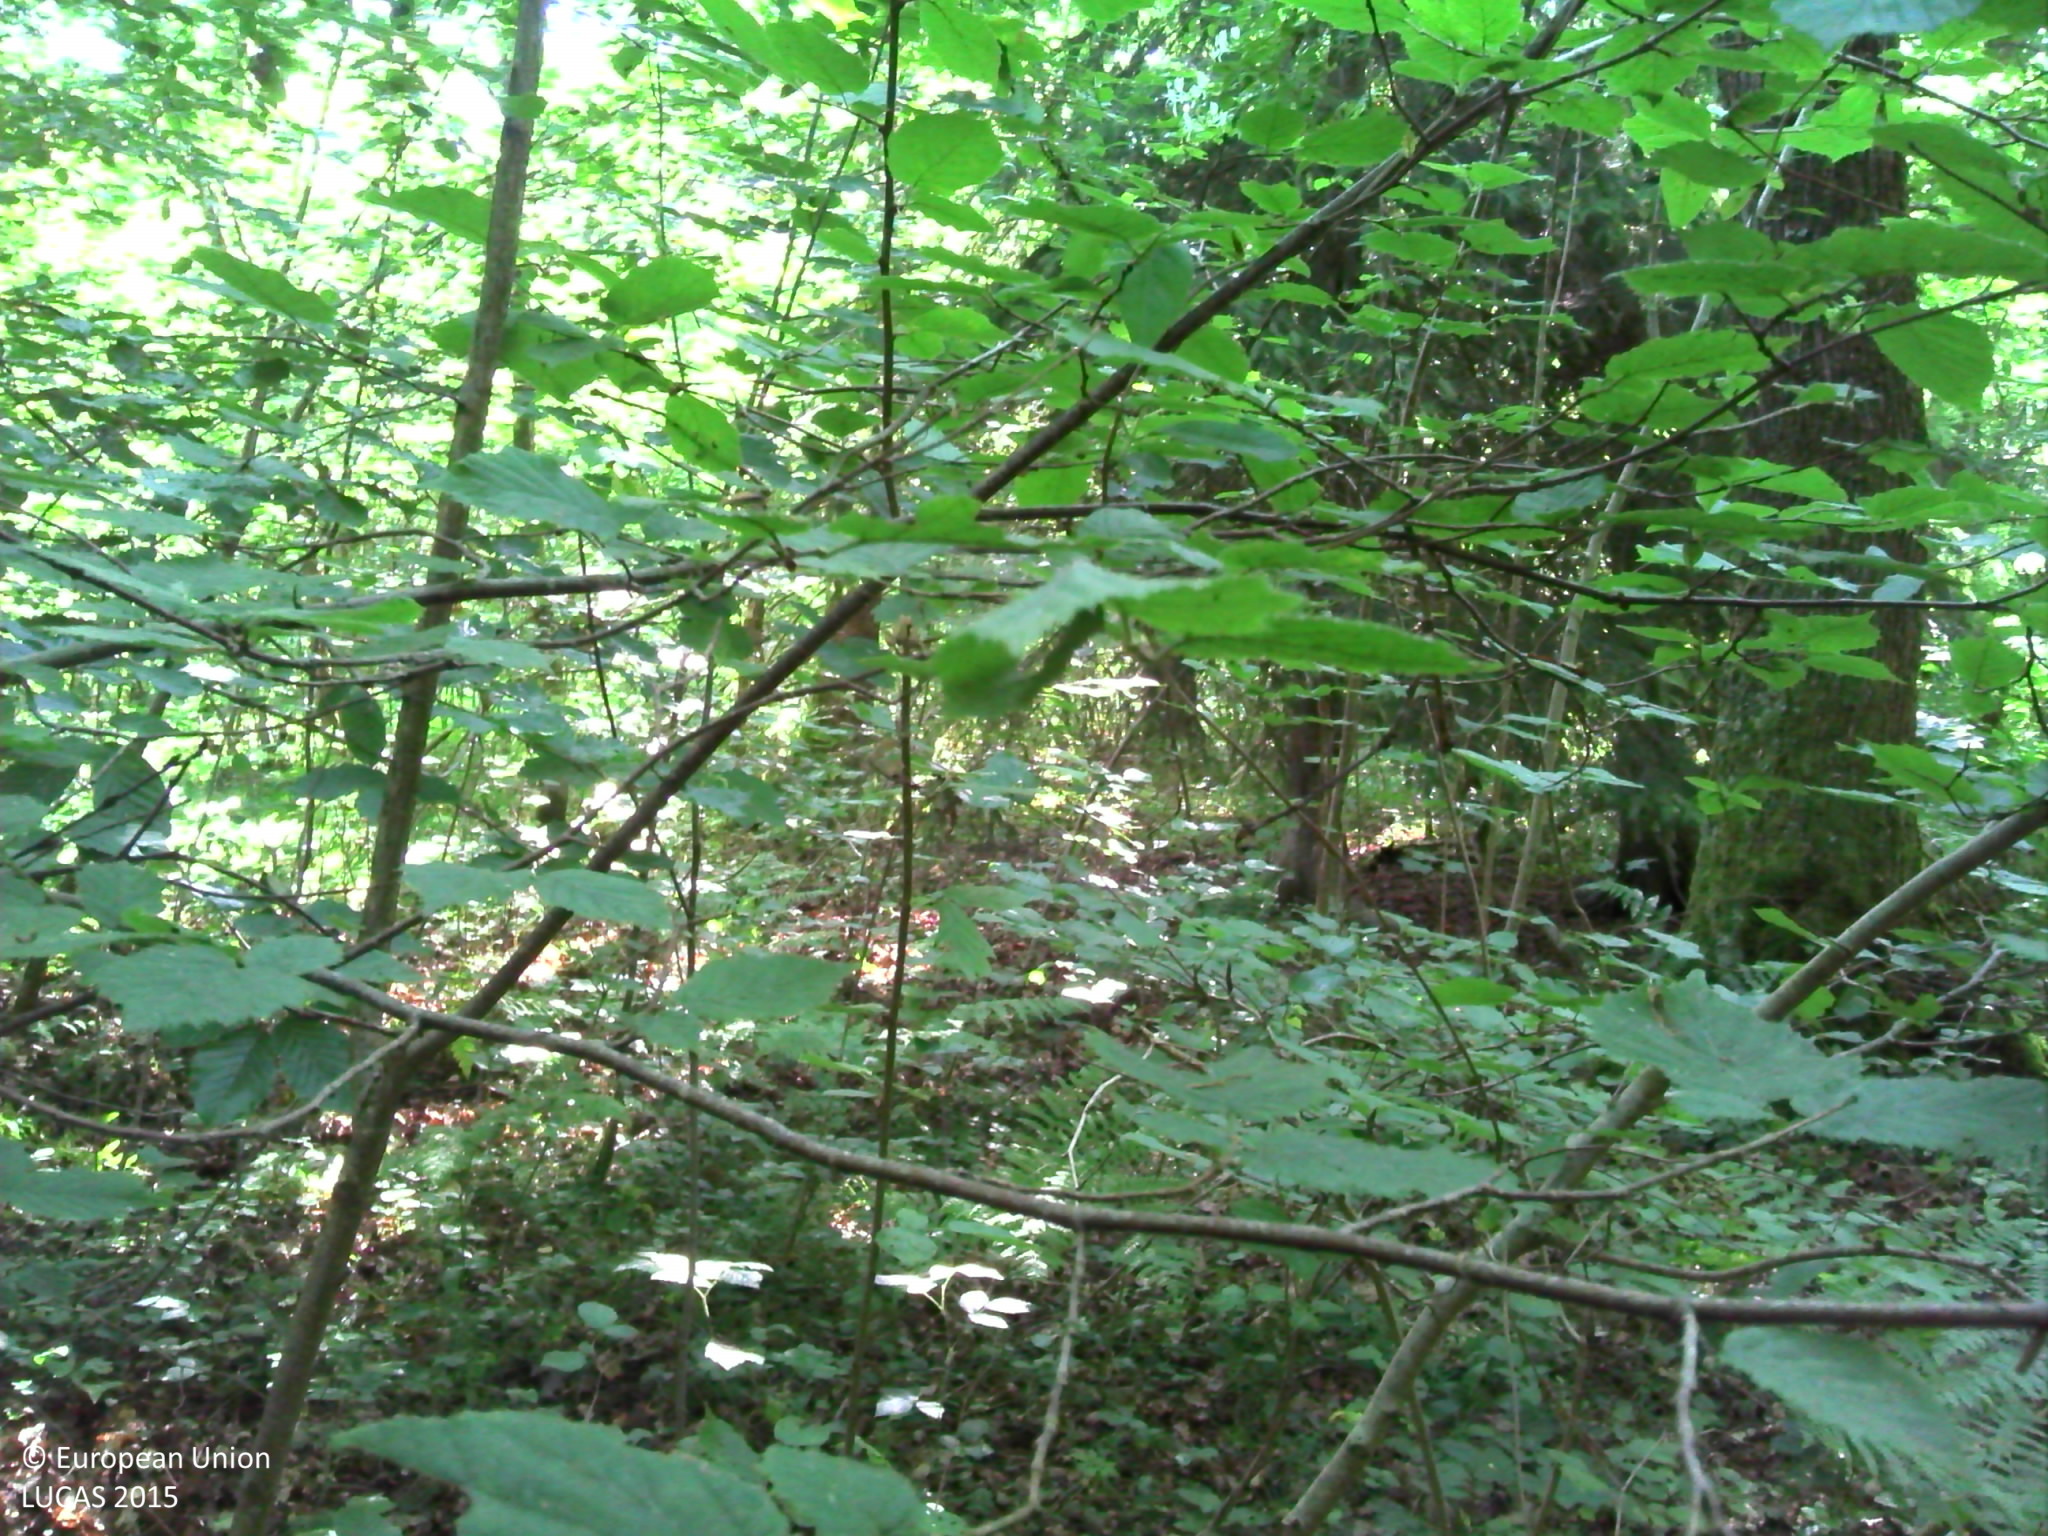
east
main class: Woodland
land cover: Broadleaved woodland
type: acidophilous oak and oak-birch forest
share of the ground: > 75 %
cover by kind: broadleaved forest trees 100 %
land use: Forestry
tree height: > 5 m
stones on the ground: < 10 %
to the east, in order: Broadleaved woodland; Grass margins; Paved roads, cycling and walking lanes; Grass margins; Broadleaved woodland
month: July
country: BE
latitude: 50.2903
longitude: 4.5923
